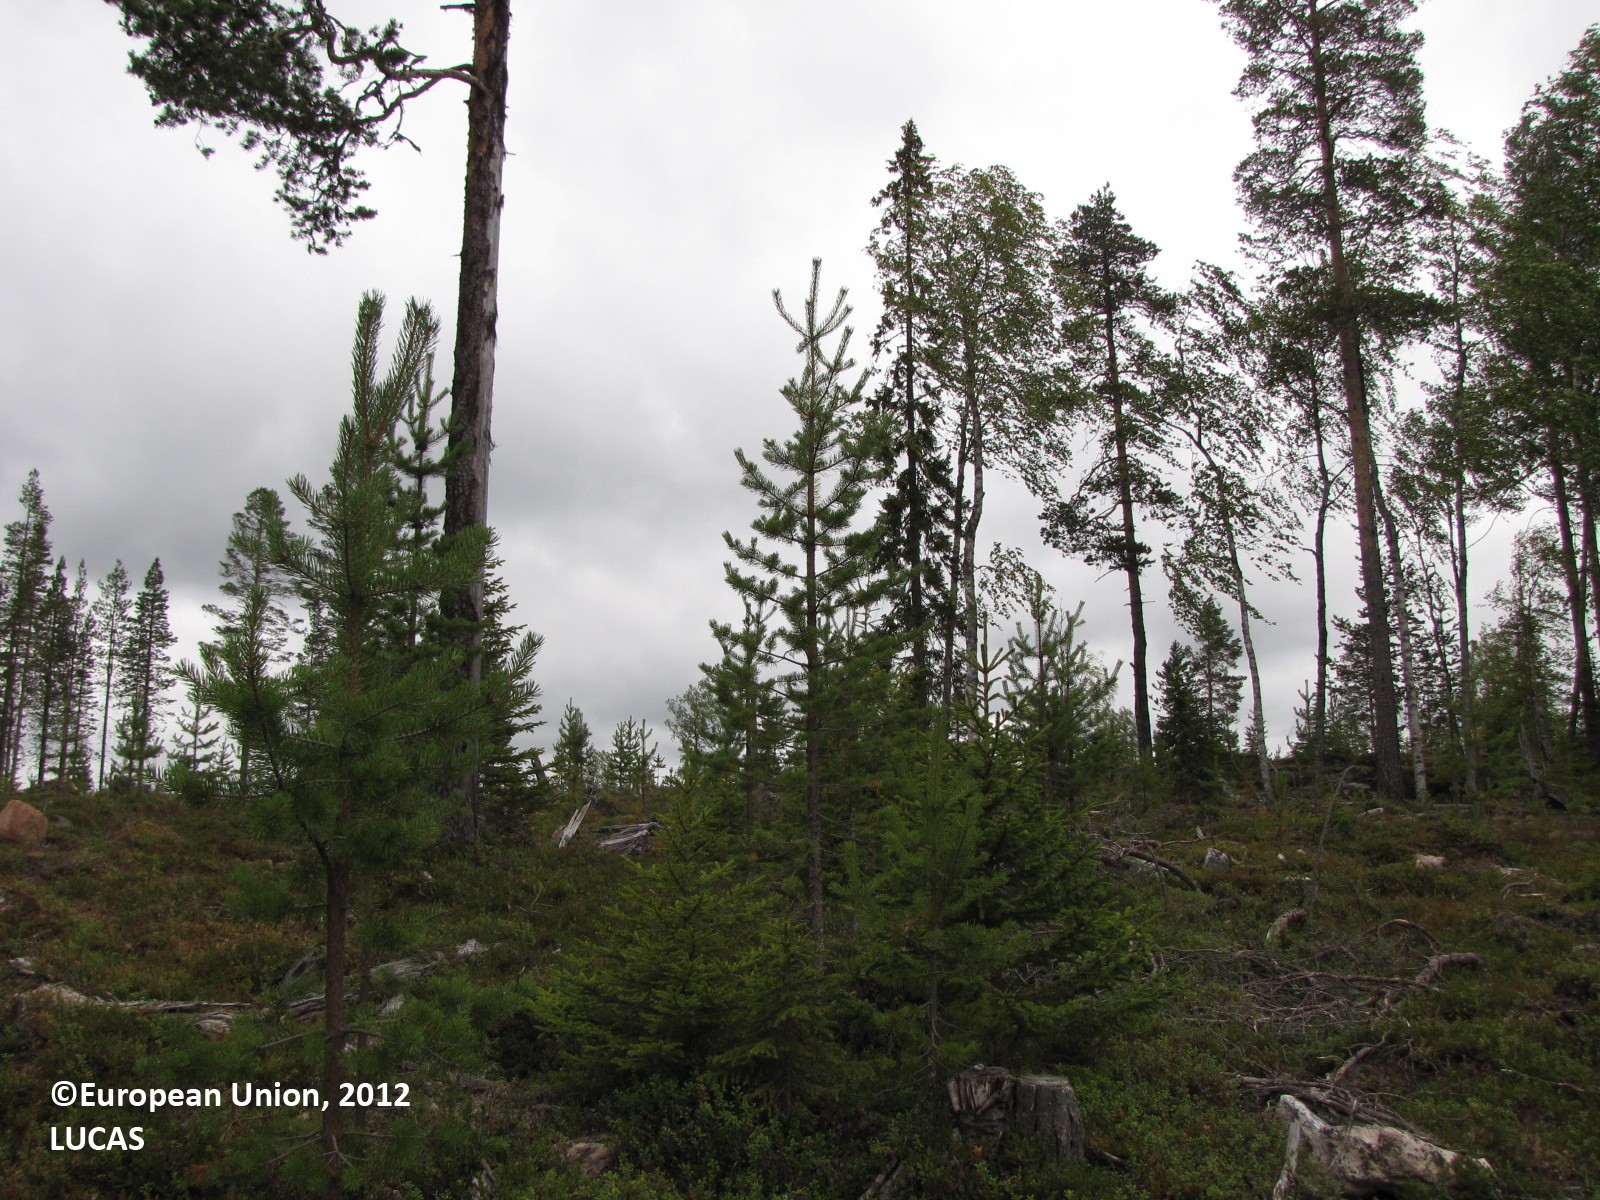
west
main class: Woodland
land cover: Pine dominated mixed woodland
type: boreal forest
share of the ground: 25 - 50 %
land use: Forestry
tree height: > 5 m
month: August
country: FI
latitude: 67.0910
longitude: 25.3143
